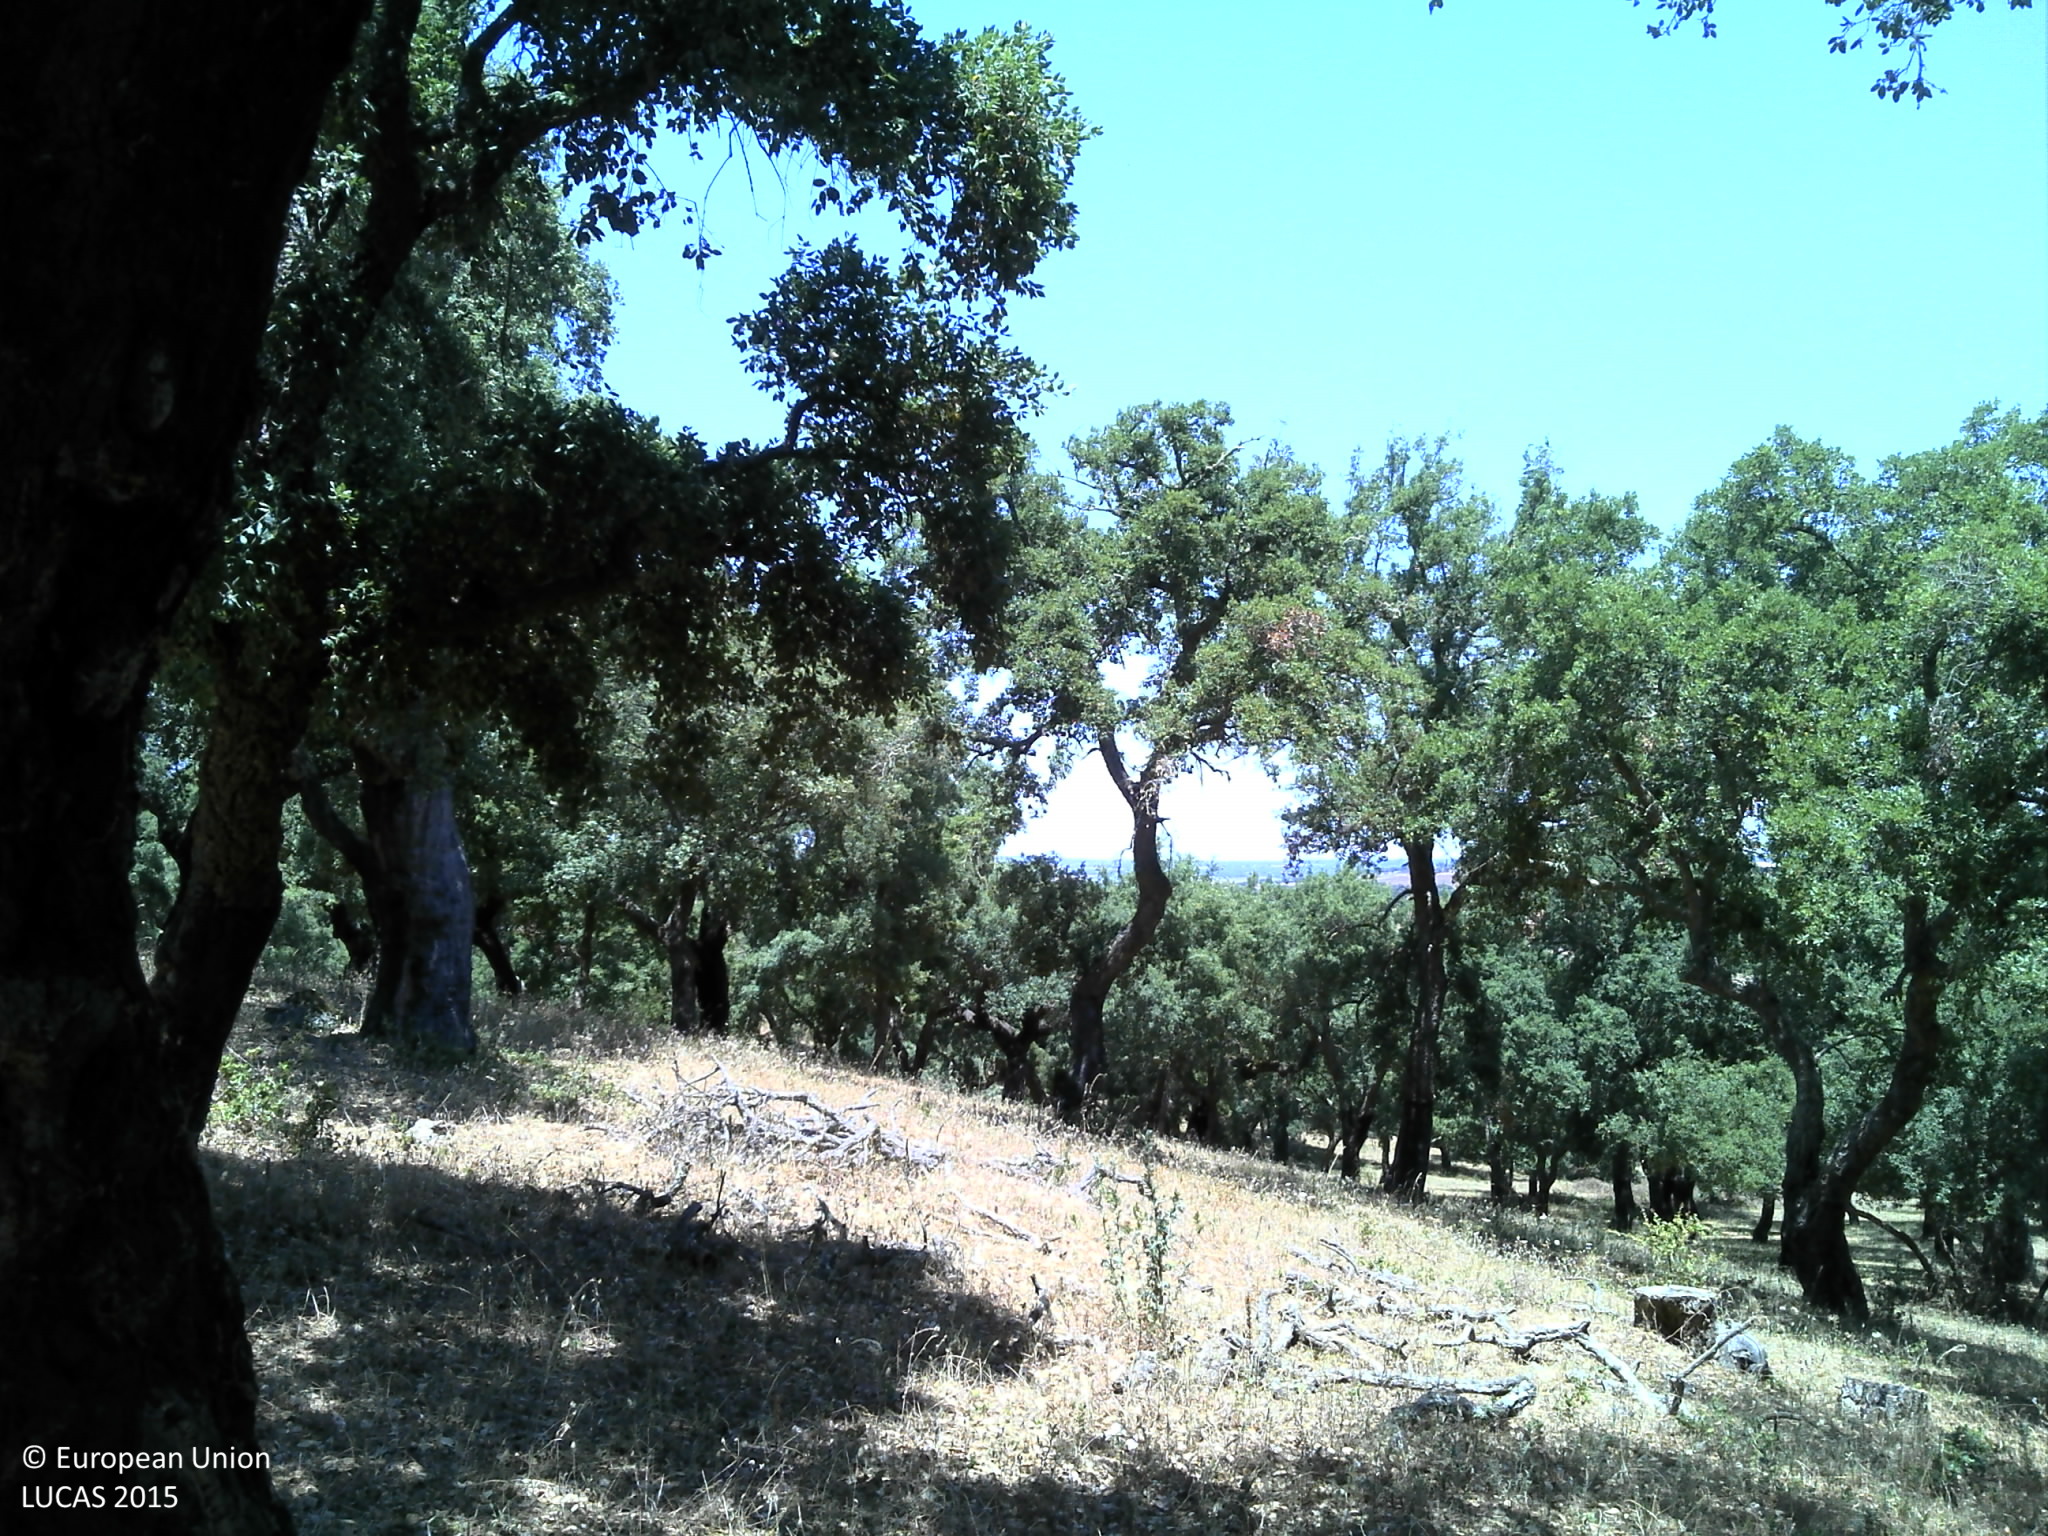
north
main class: Woodland
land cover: Broadleaved woodland
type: broadleaved evergreen forest
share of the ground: 50 - 75 %
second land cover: Grassland without tree/shrub cover
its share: 10 - 25 %
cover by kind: broadleaved forest trees 75 %, unconsolidated bare surface 15 %, herbaceous plants 10 %
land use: Forestry
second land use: Agriculture (excluding fallow land and kitchen gardens)
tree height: > 5 m
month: June
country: PT
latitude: 38.6124
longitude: -8.1571
